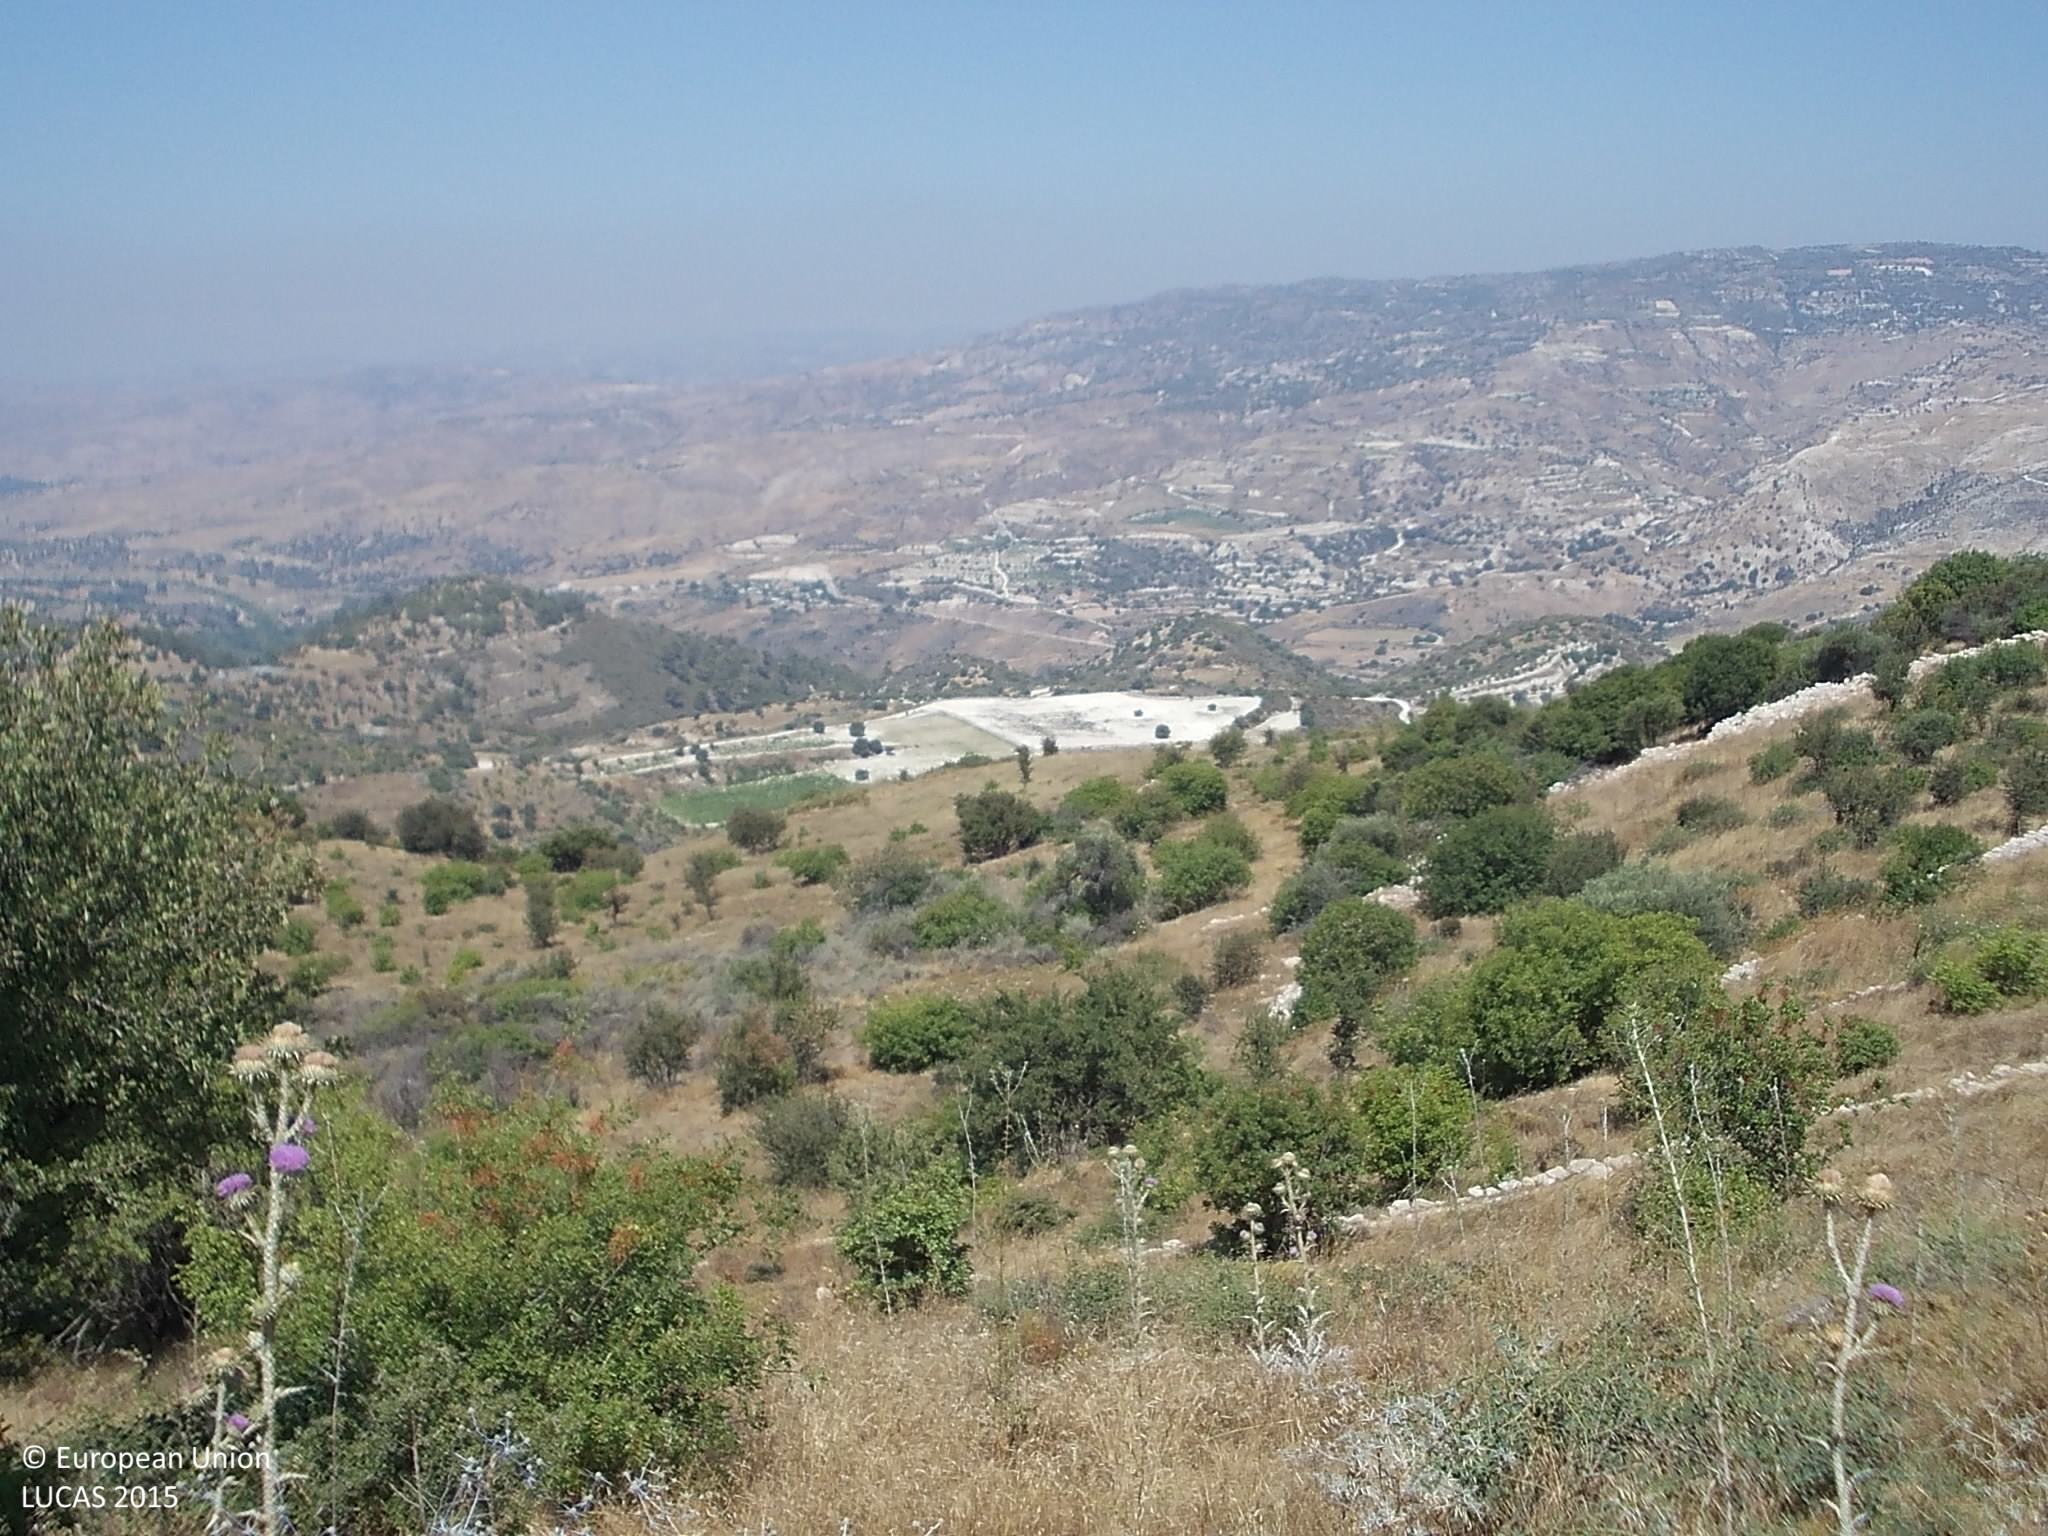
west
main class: Shrubland
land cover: Shrubland without tree cover
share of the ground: 50 - 75 %
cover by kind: shrubs 70 %, herbaceous plants 20 %, unconsolidated bare surface 10 %
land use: Semi-natural and natural areas not in use
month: July
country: CY
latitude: 34.7891
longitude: 32.7242
